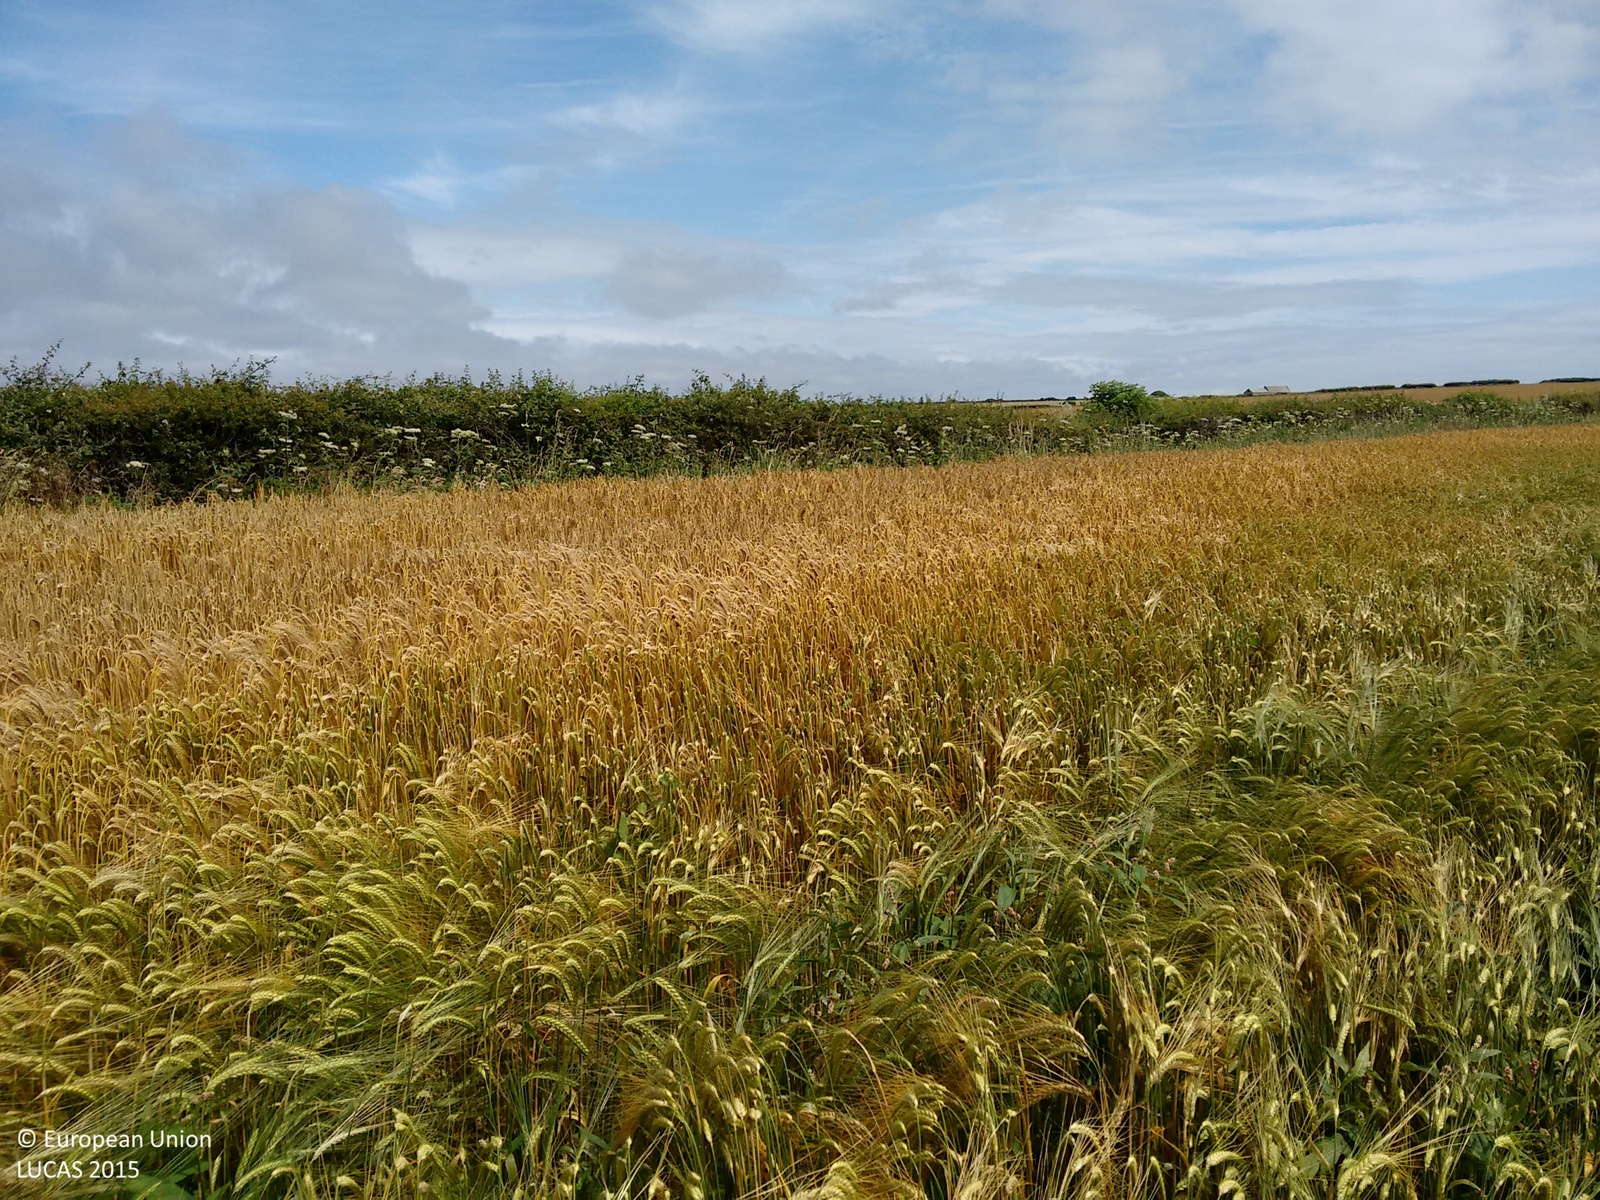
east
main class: Cropland
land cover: Barley
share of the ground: > 75 %
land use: Agriculture (excluding fallow land and kitchen gardens)
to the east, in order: Barley; Managed hedges; Barley
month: July
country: GB
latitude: 51.4334
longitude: -3.5346
